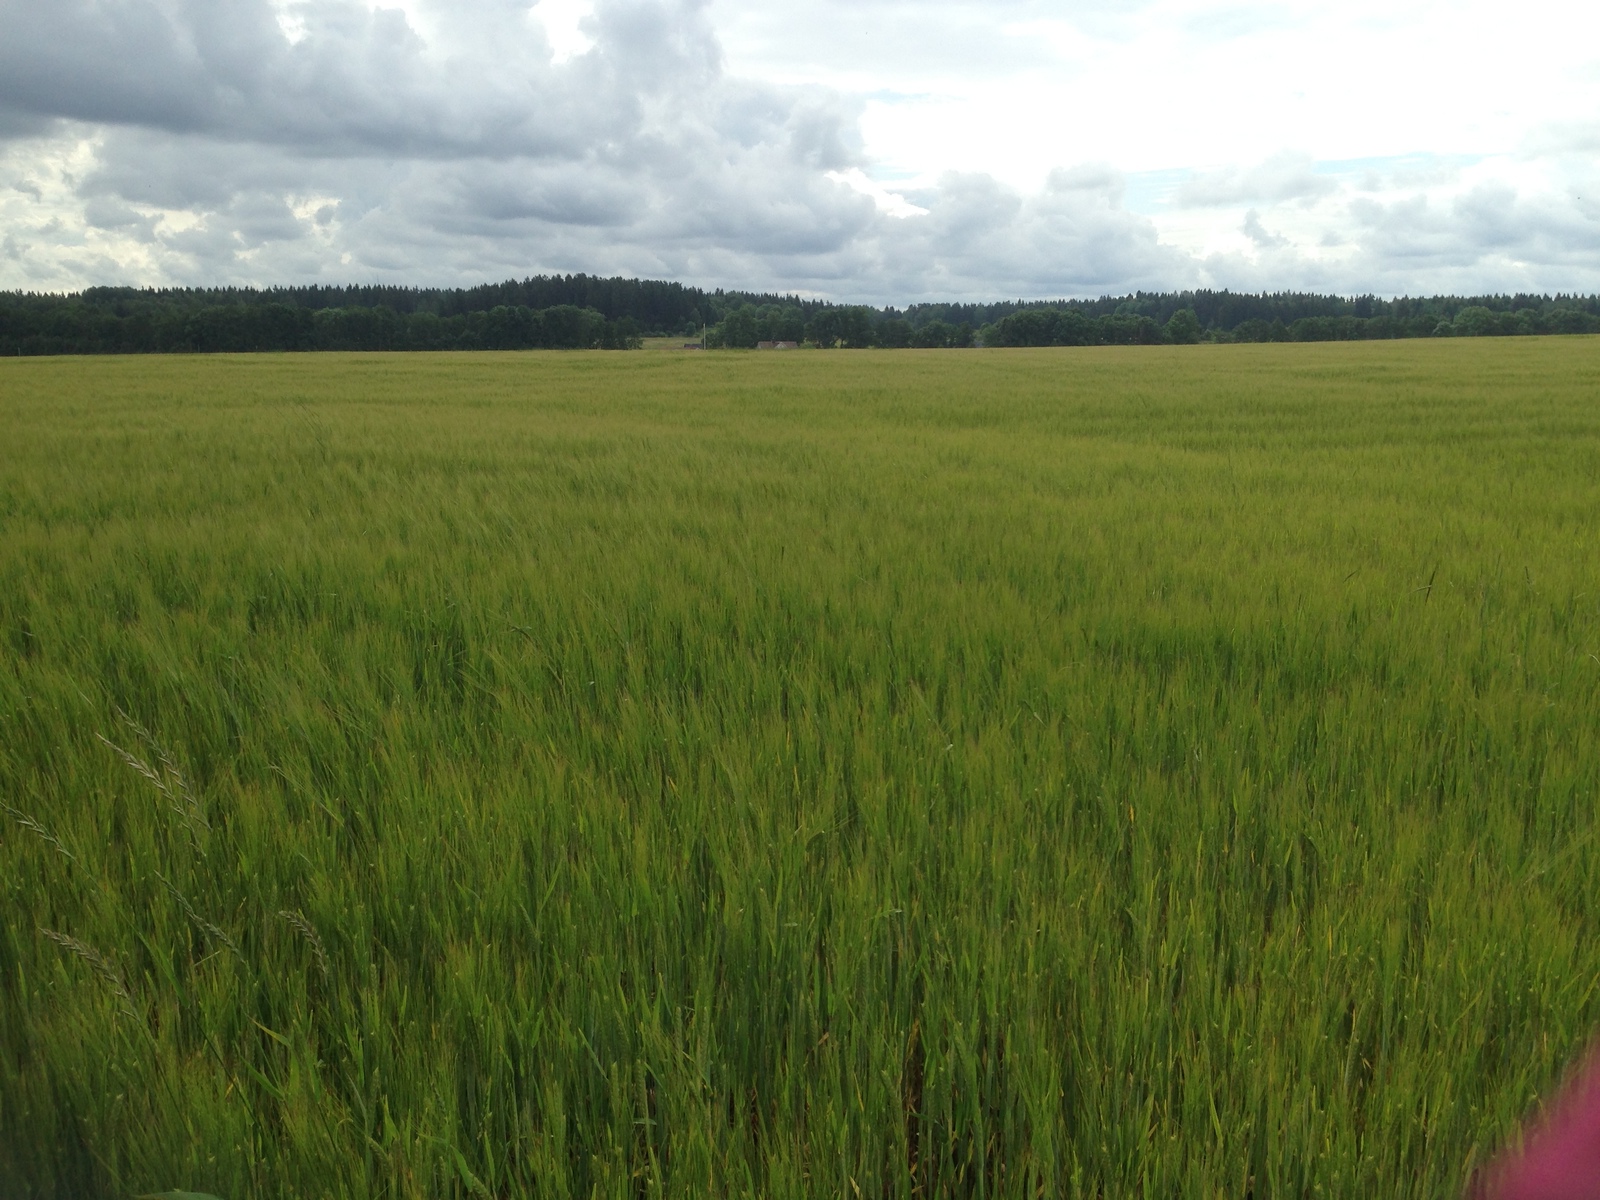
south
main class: Cropland
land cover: Barley
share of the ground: > 75 %
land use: Agriculture (excluding fallow land and kitchen gardens)
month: July
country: SE
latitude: 59.8598
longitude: 18.6588
